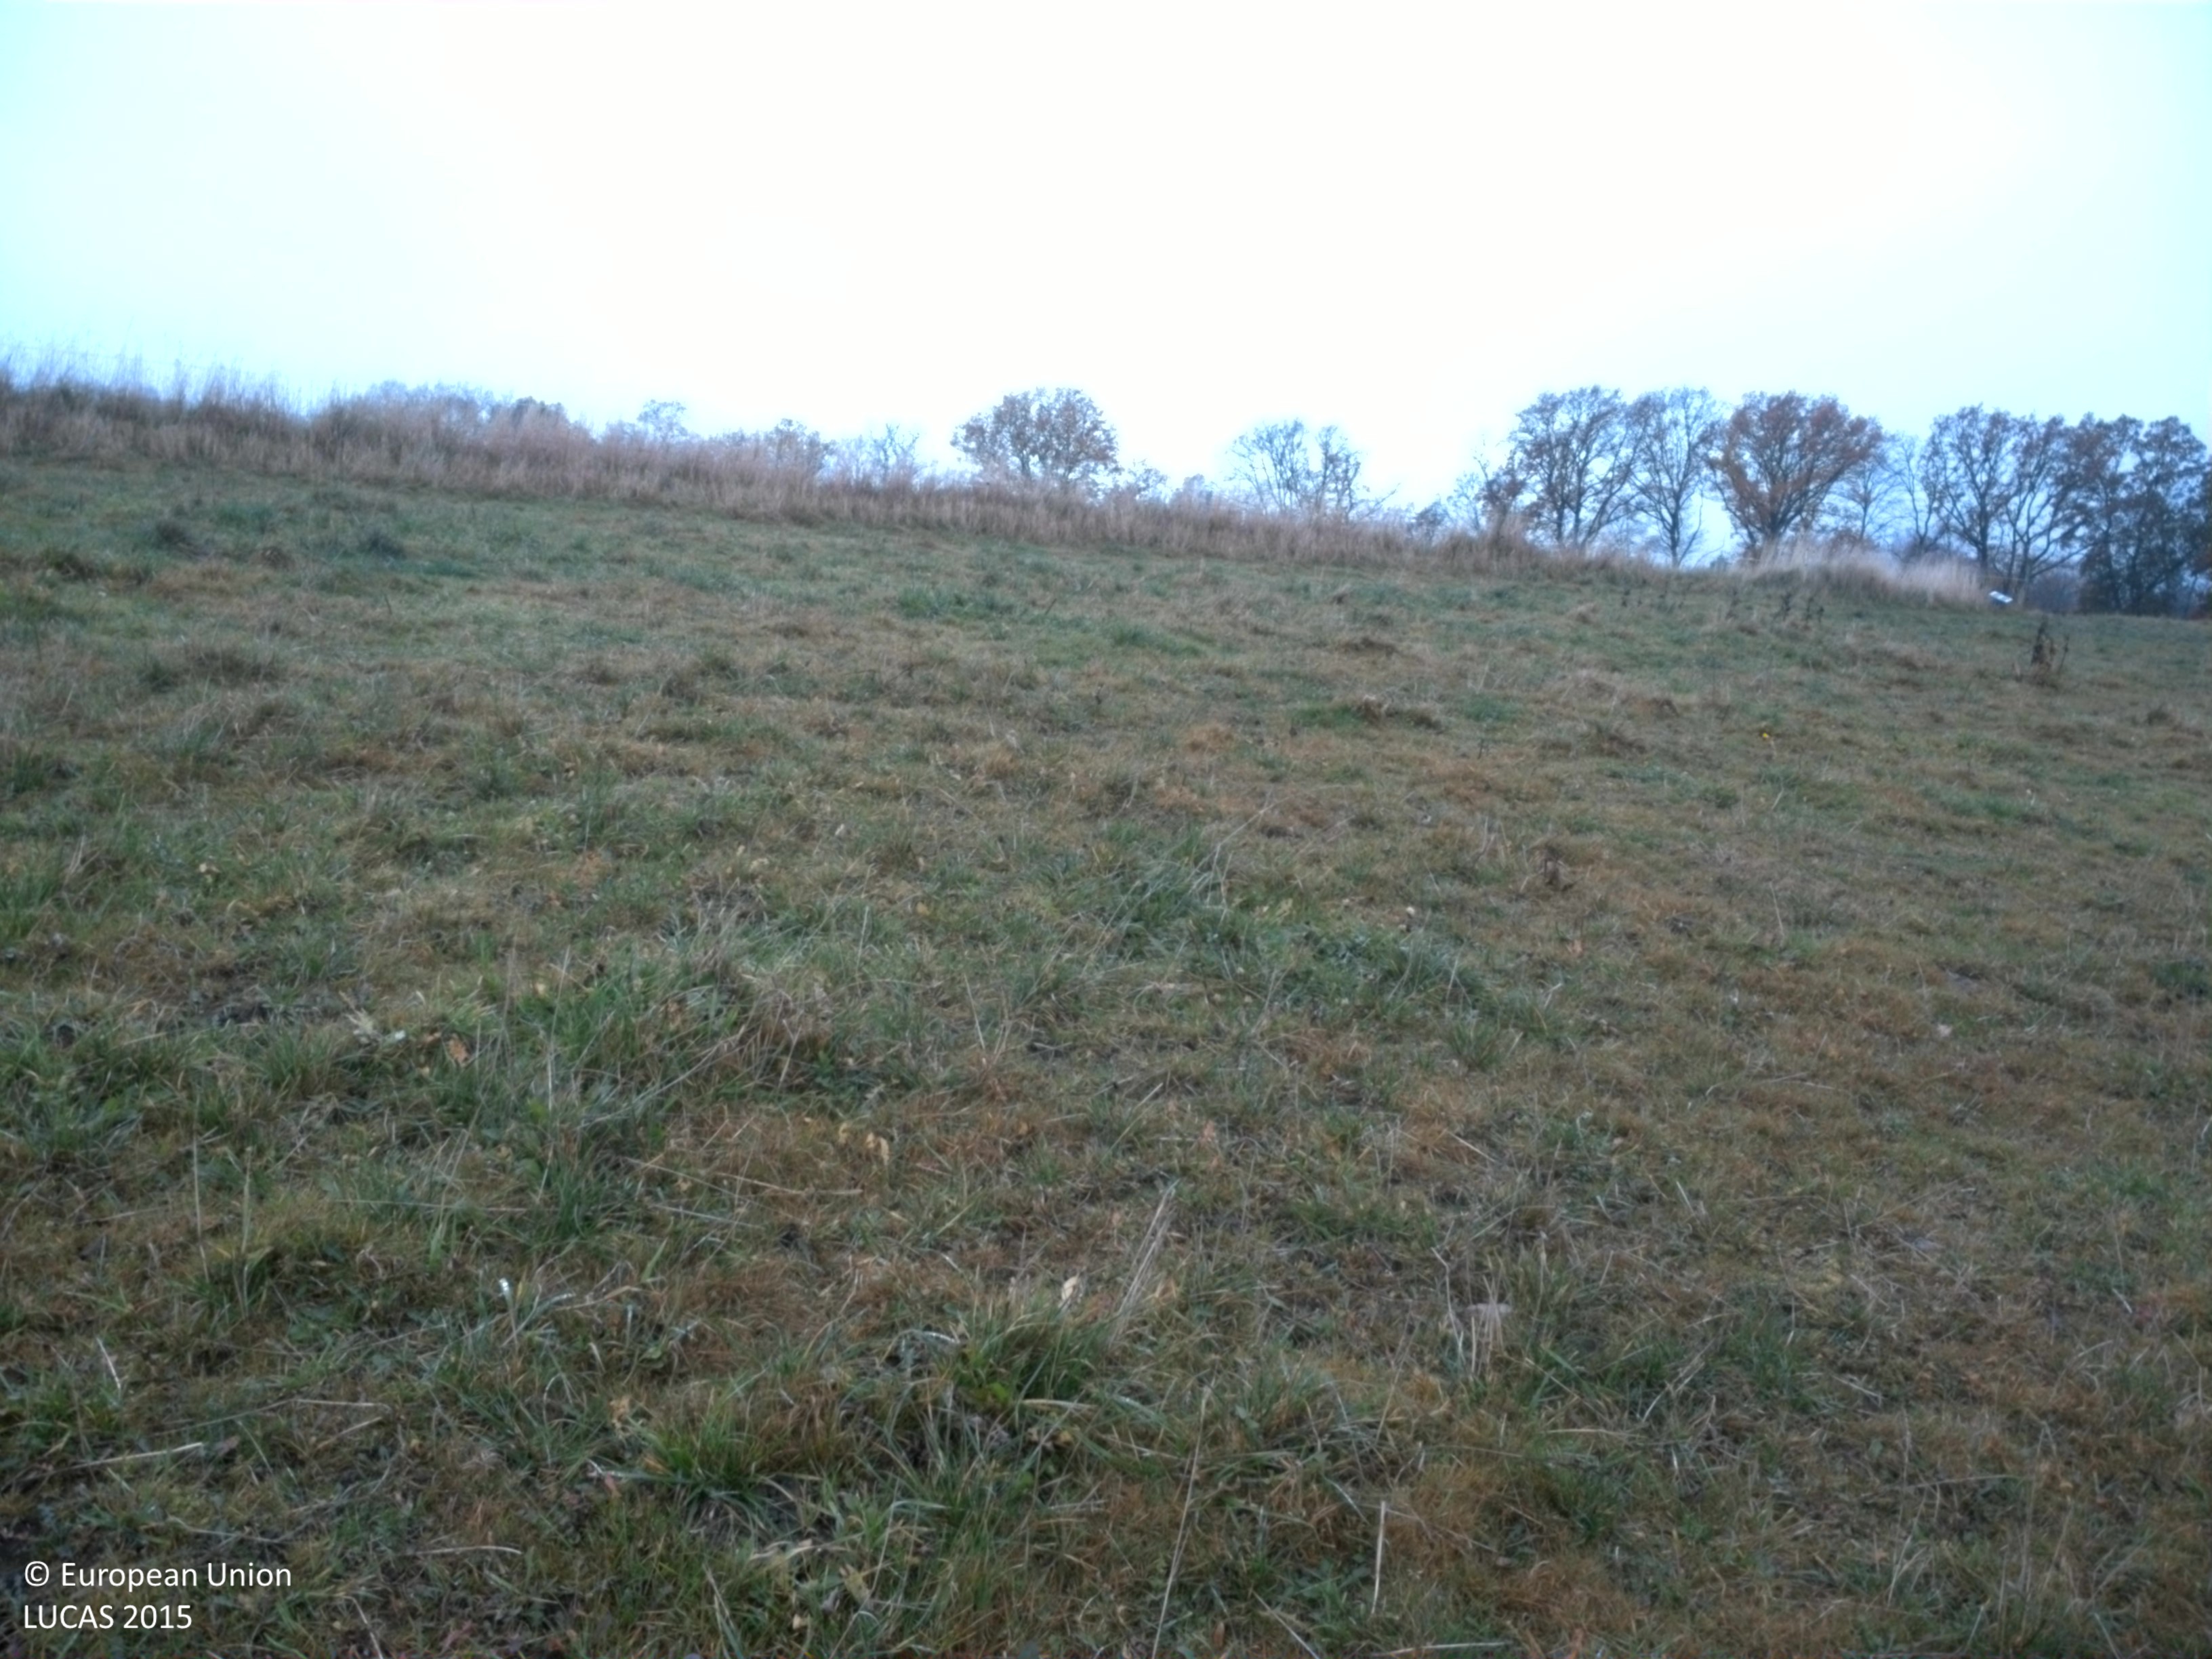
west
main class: Grassland
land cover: Grassland without tree/shrub cover
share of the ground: > 75 %
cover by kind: herbaceous plants 100 %
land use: Agriculture (excluding fallow land and kitchen gardens)
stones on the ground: < 10 %
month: November
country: SE
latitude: 56.0433
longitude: 13.0636
